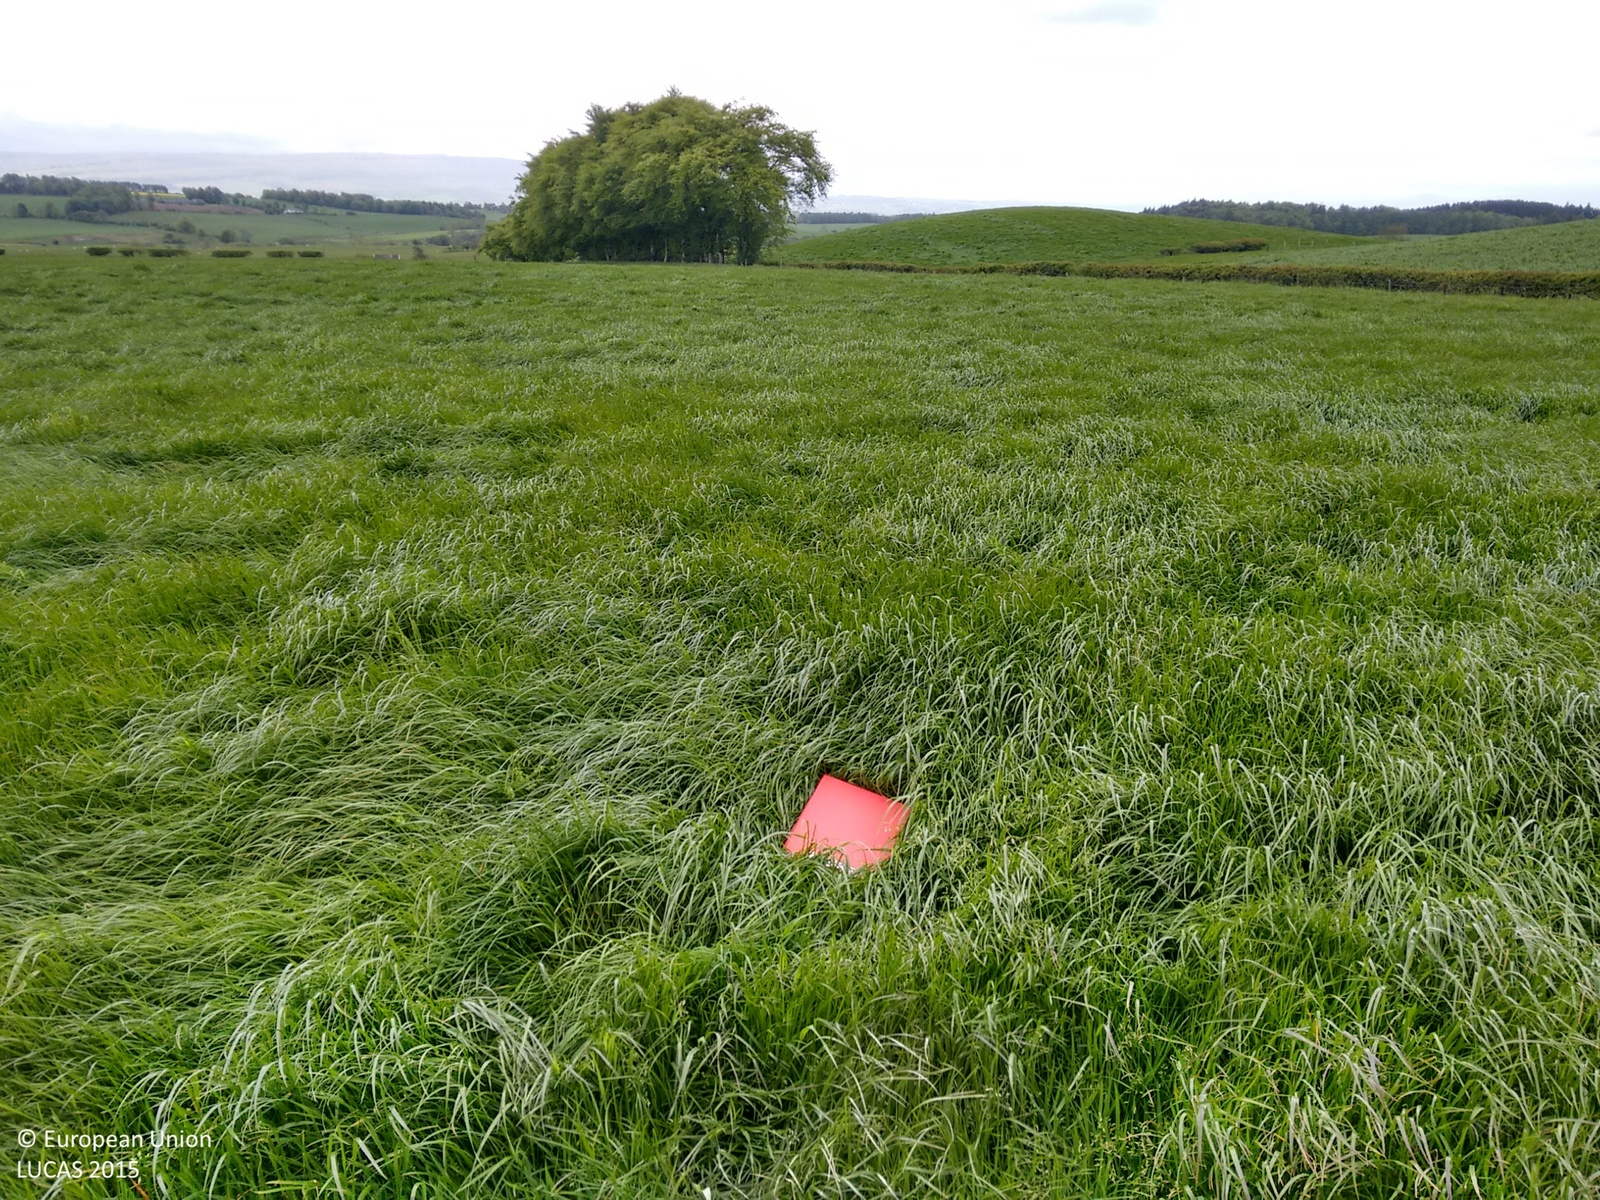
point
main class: Grassland
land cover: Grassland without tree/shrub cover
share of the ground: > 75 %
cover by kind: herbaceous plants 100 %
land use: Agriculture (excluding fallow land and kitchen gardens)
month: June
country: GB
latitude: 56.2015
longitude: -3.9969
